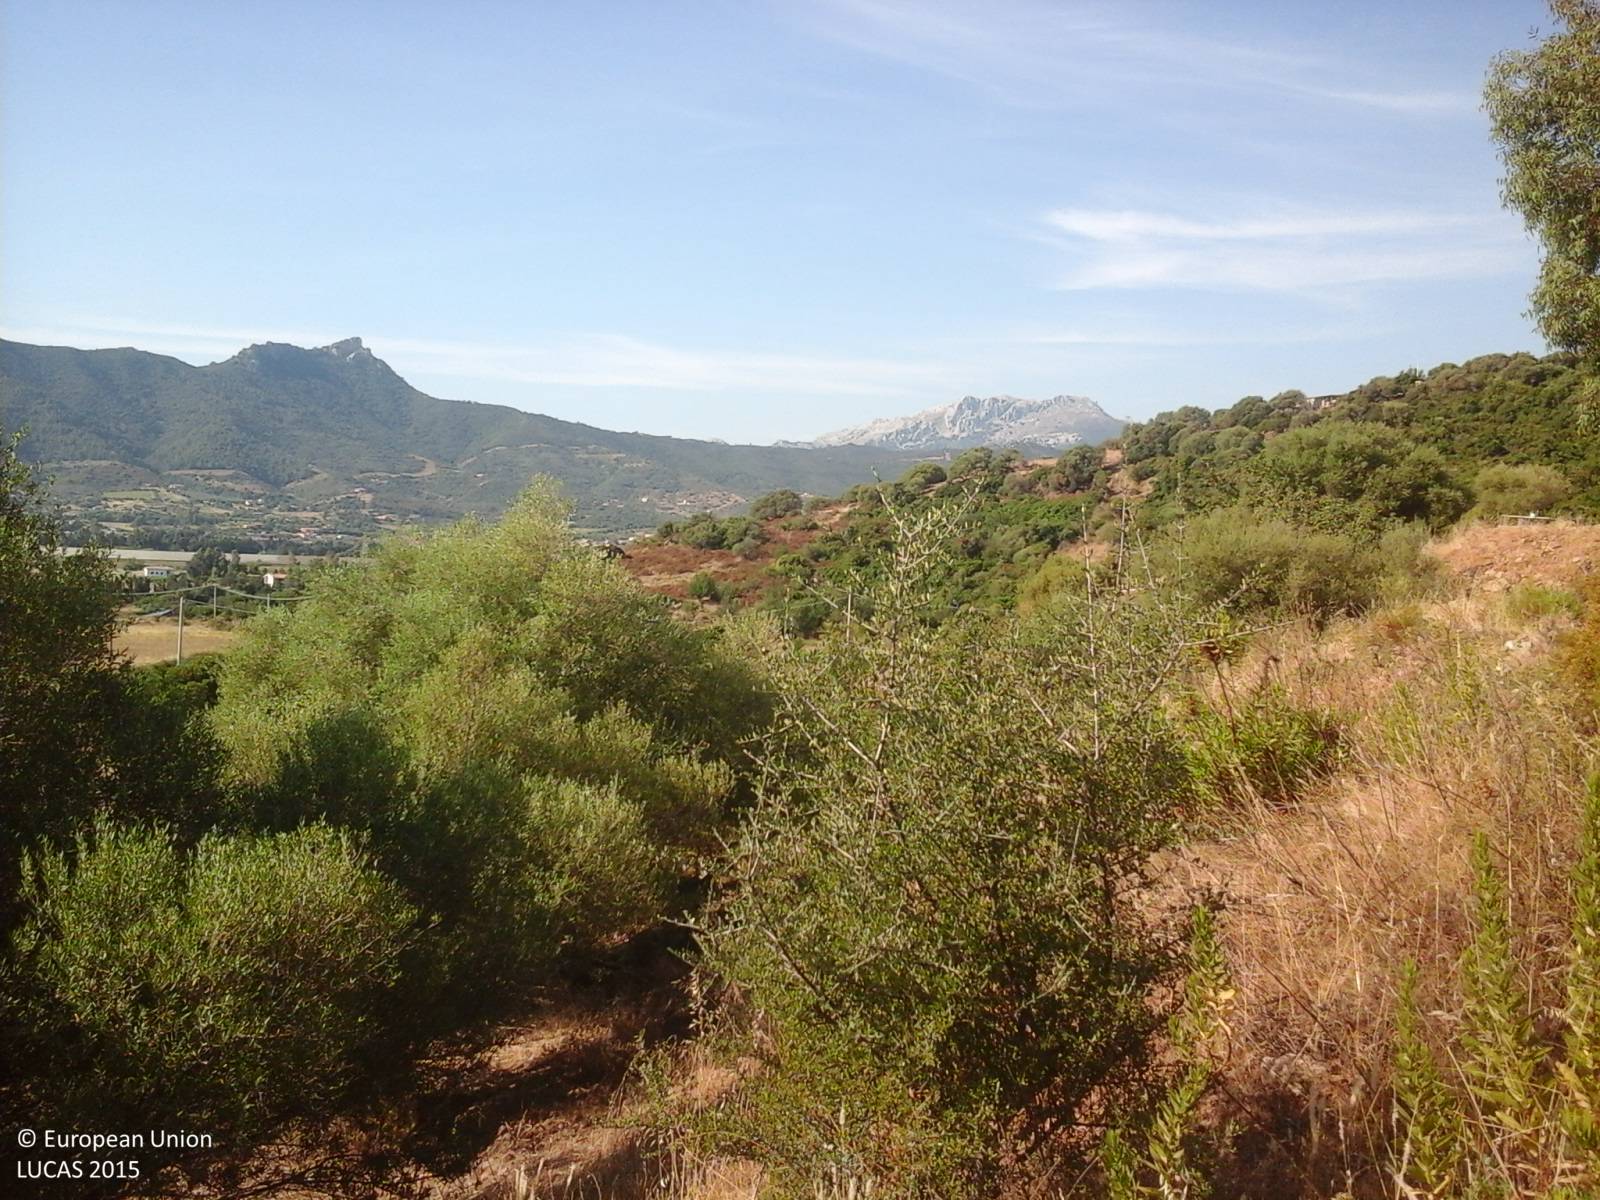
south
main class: Shrubland
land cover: Shrubland without tree cover
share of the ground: > 75 %
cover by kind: shrubs 85 %, unconsolidated bare surface 10 %, herbaceous plants 5 %
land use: Semi-natural and natural areas not in use
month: June
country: IT
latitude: 40.6469
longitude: 9.6823
